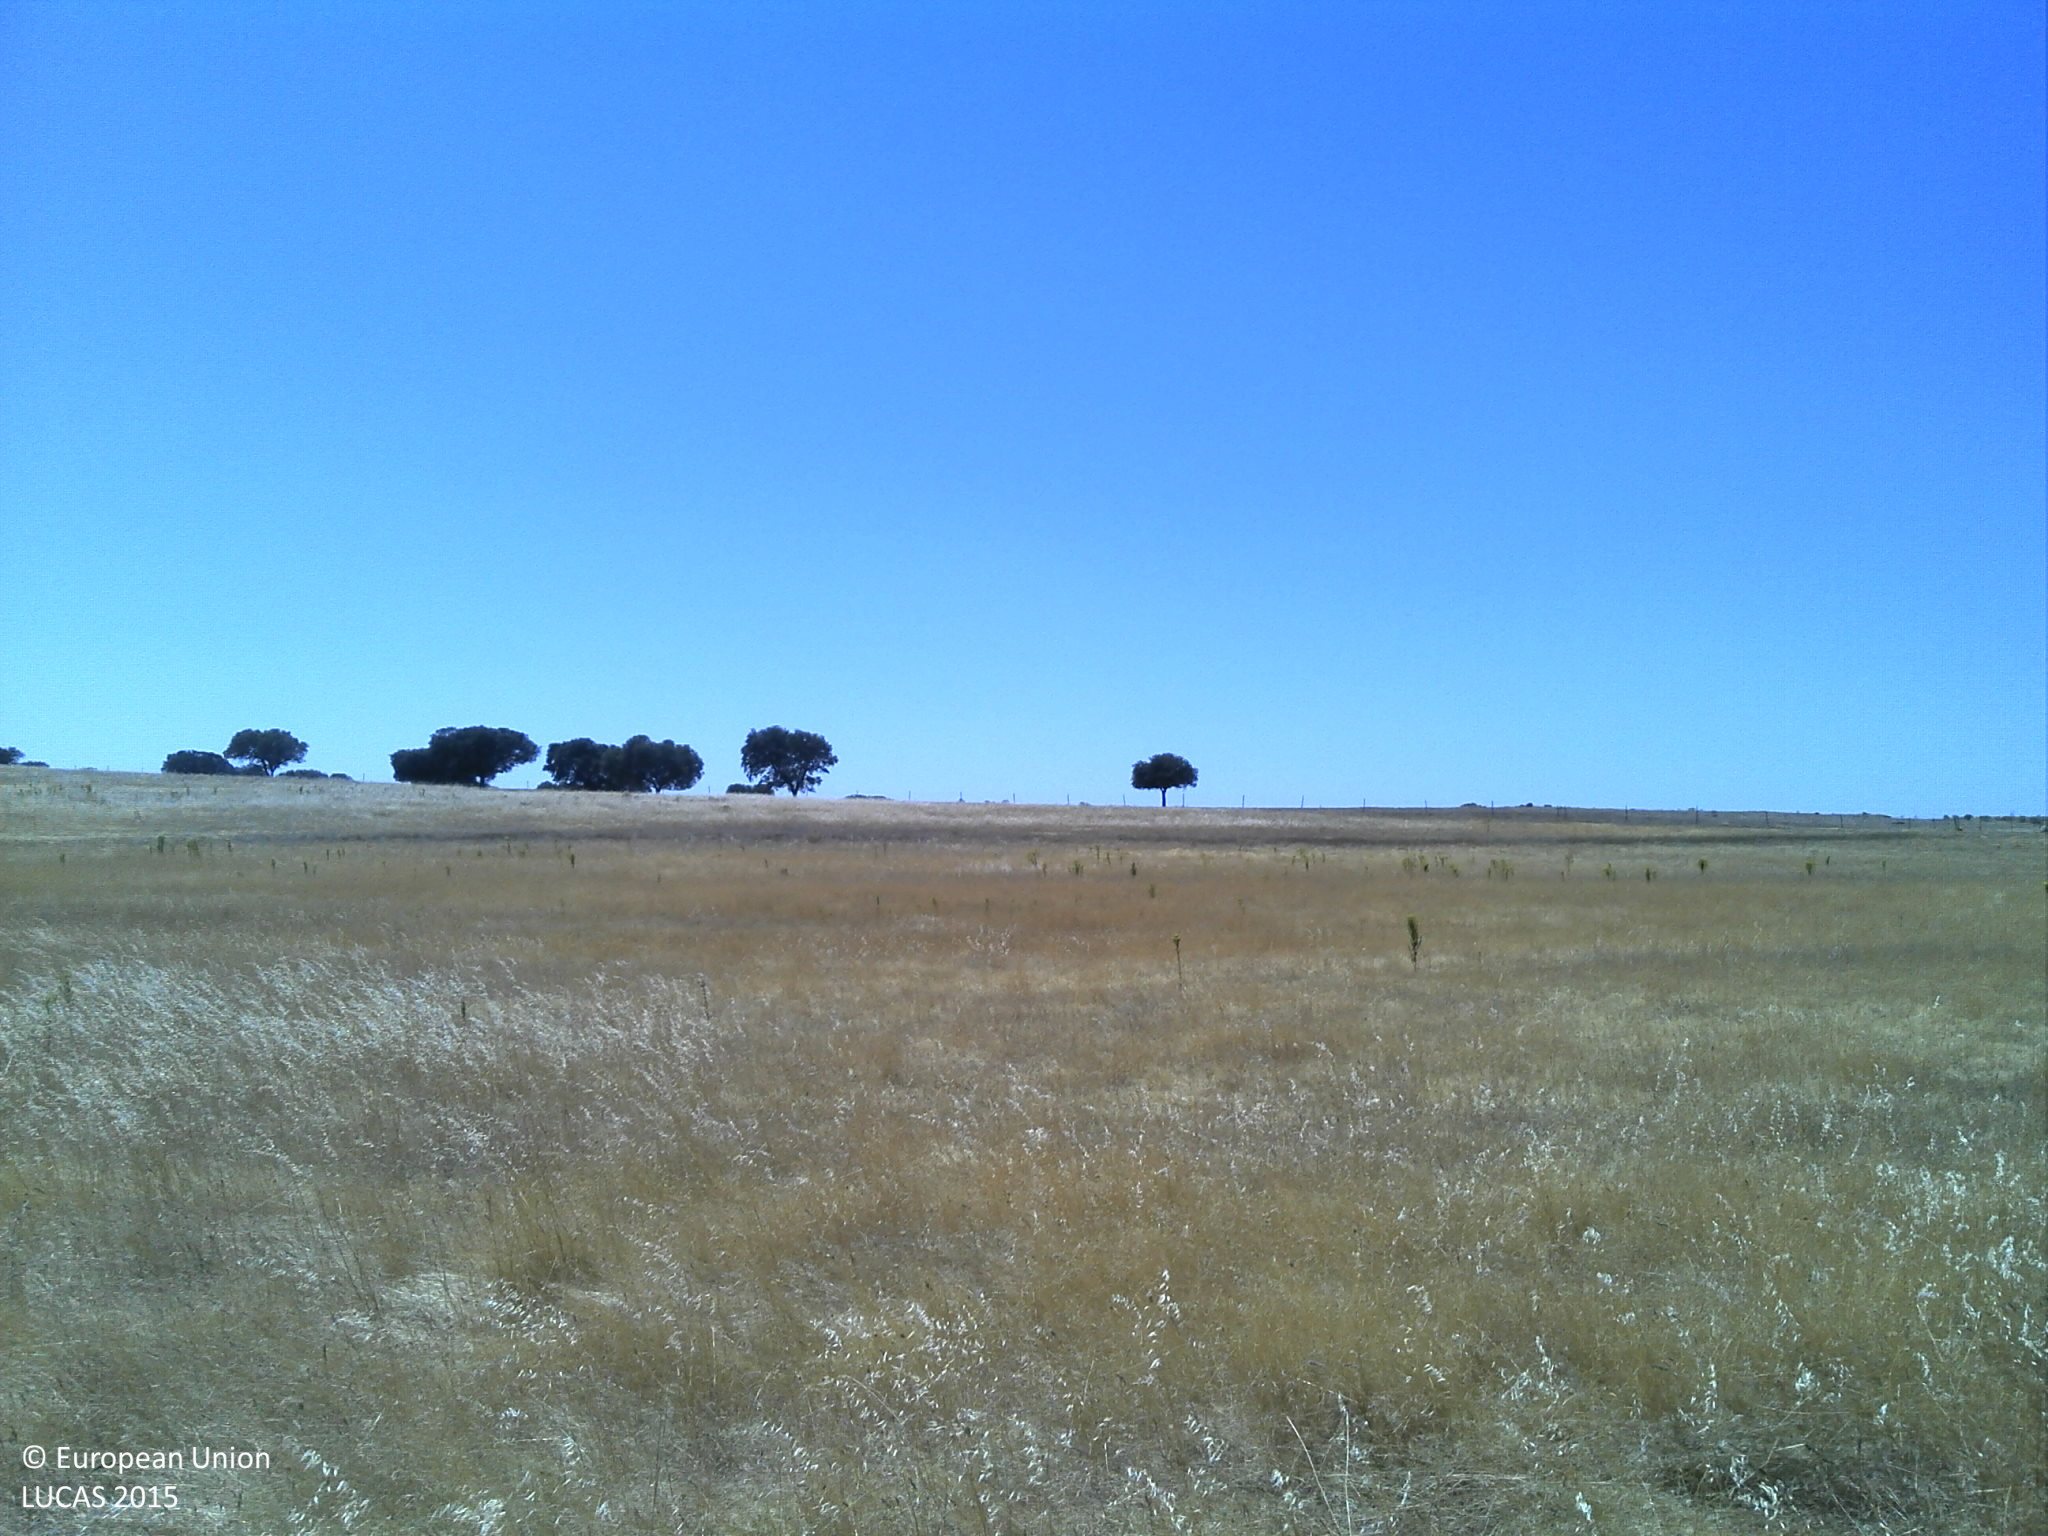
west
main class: Grassland
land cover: Grassland with sparse tree/shrub cover
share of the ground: > 75 %
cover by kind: herbaceous plants 75 %, unconsolidated bare surface 20 %, broadleaved forest trees 5 %
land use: Agriculture (excluding fallow land and kitchen gardens)
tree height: > 5 m
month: July
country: PT
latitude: 39.0947
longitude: -7.5575
